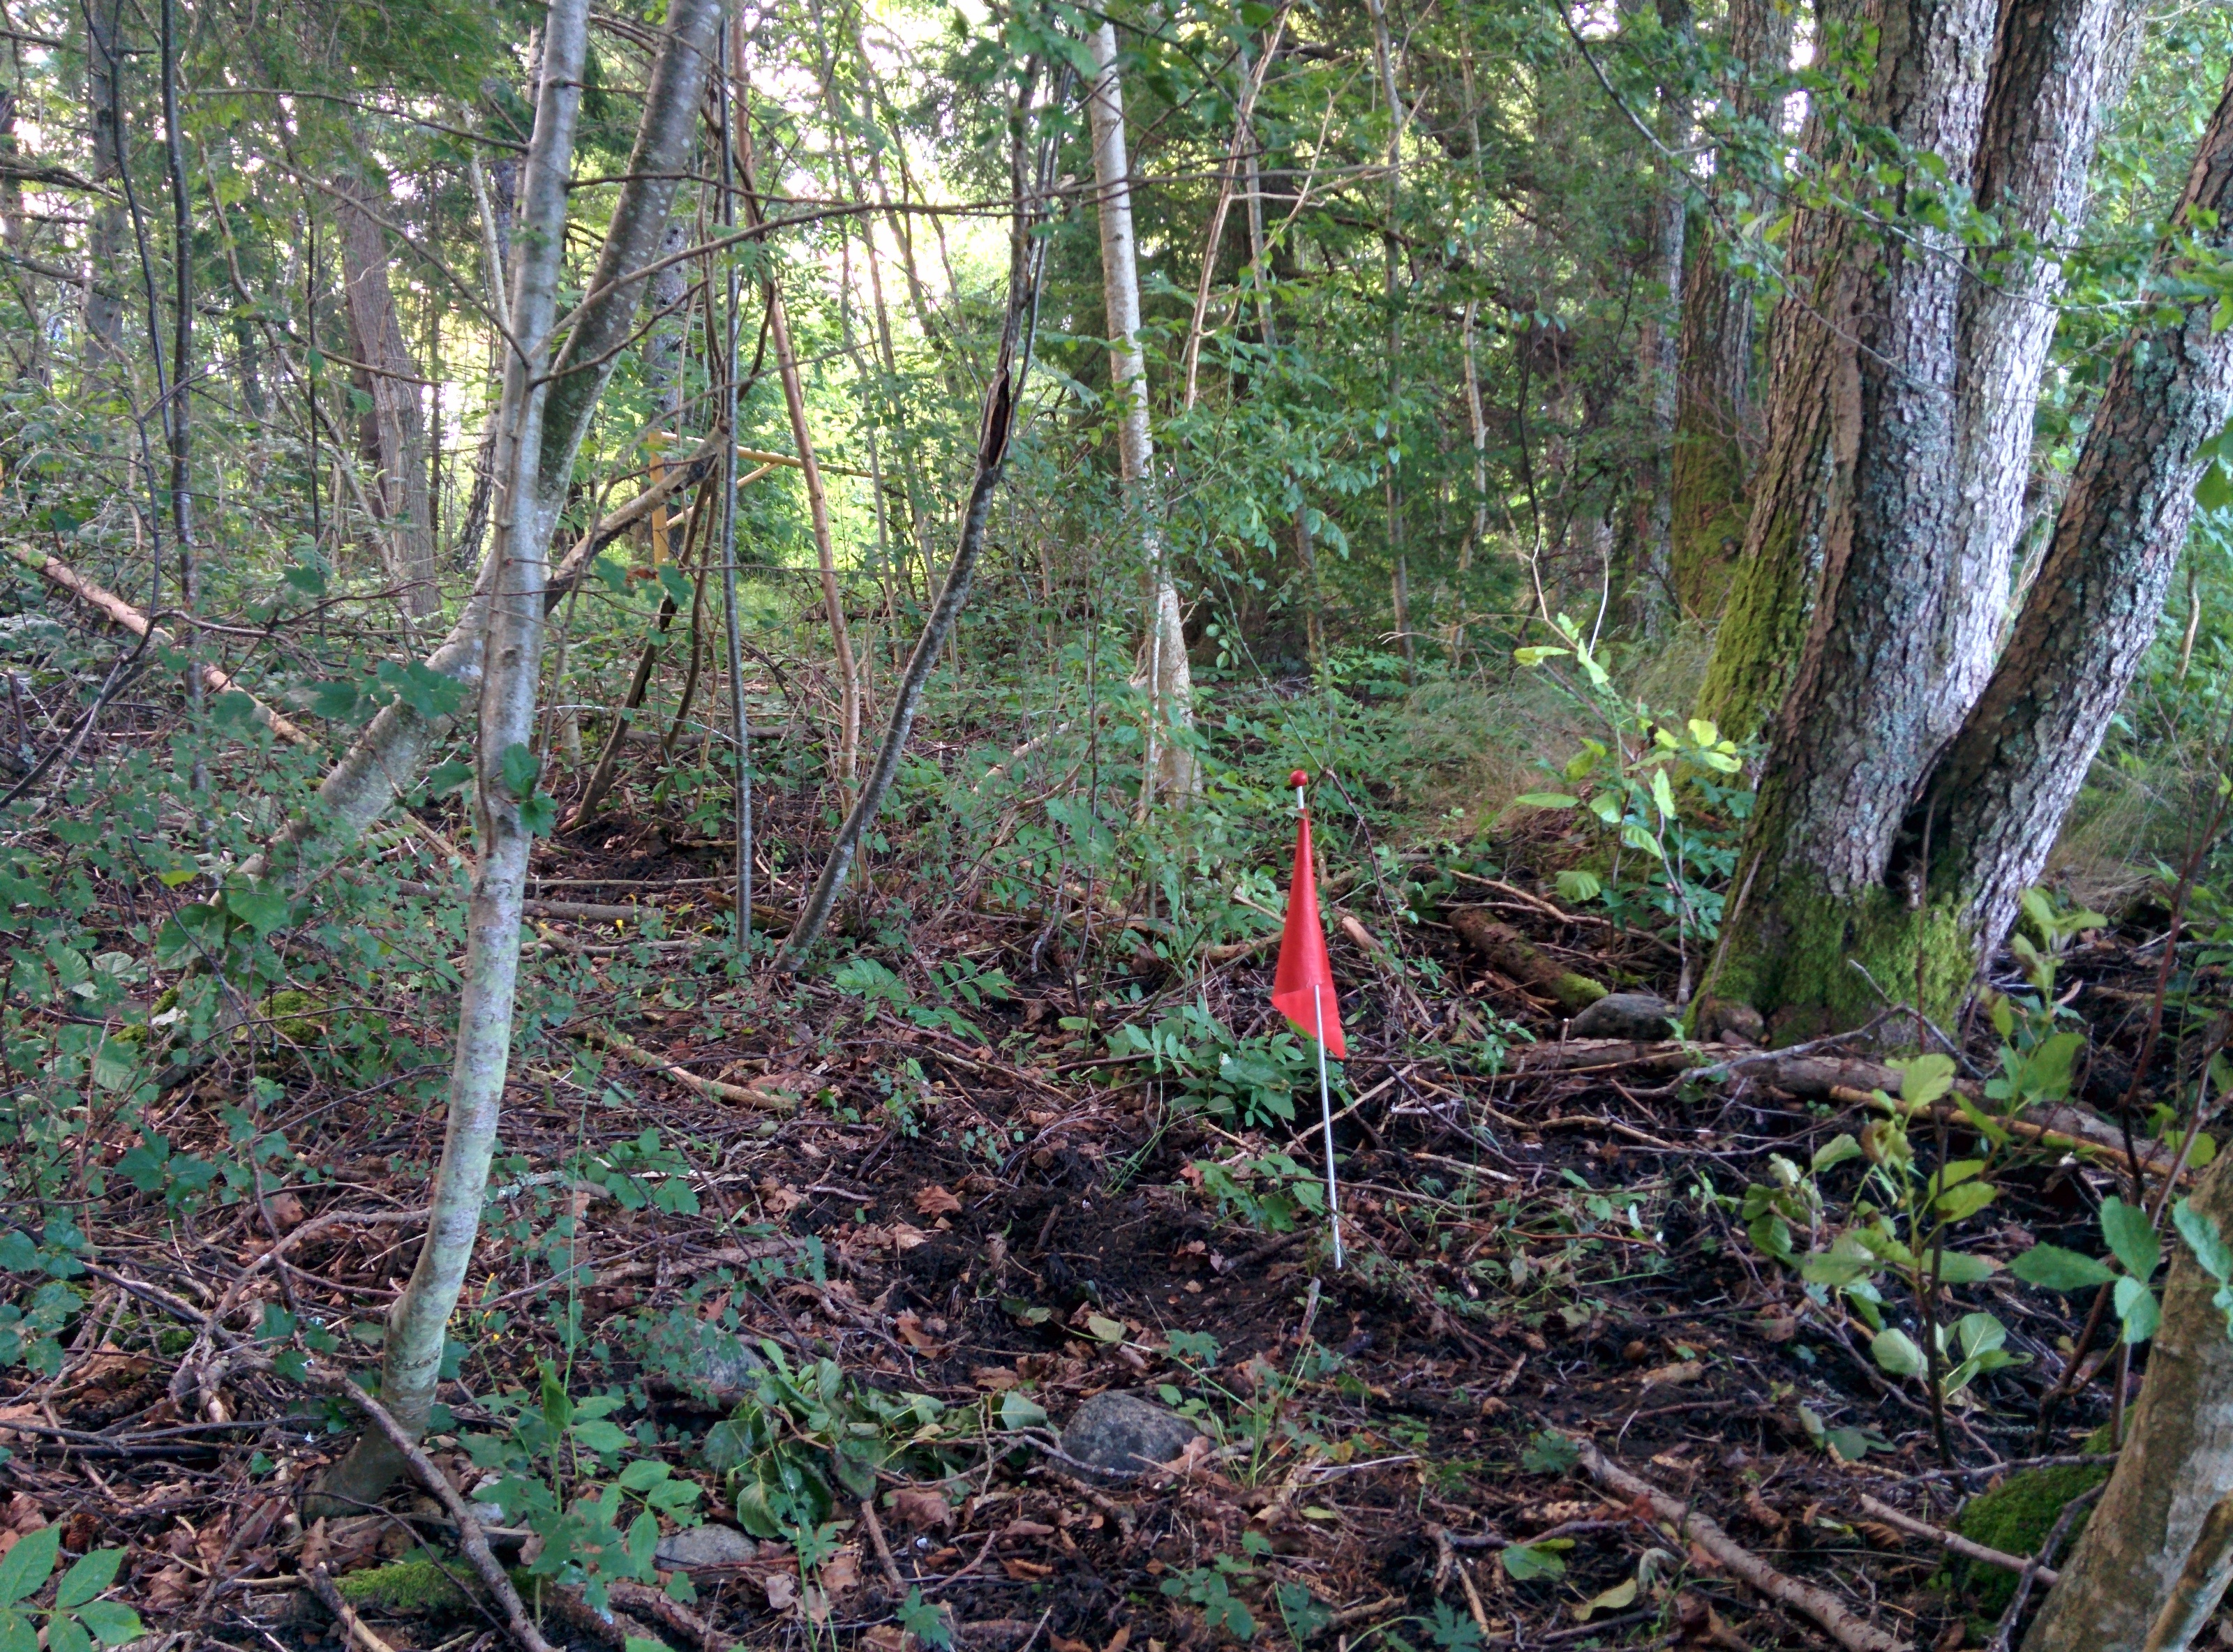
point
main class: Woodland
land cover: Broadleaved woodland
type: hemiboreal forest and nemoral coniferous forest and mixed broadleaved-coniferous forest
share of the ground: > 75 %
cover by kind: broadleaved forest trees 75 %, coniferous forest trees 10 %, unconsolidated bare surface 10 %, herbaceous plants 5 %
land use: Forestry
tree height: > 5 m
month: August
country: SE
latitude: 58.9391
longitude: 17.6965
